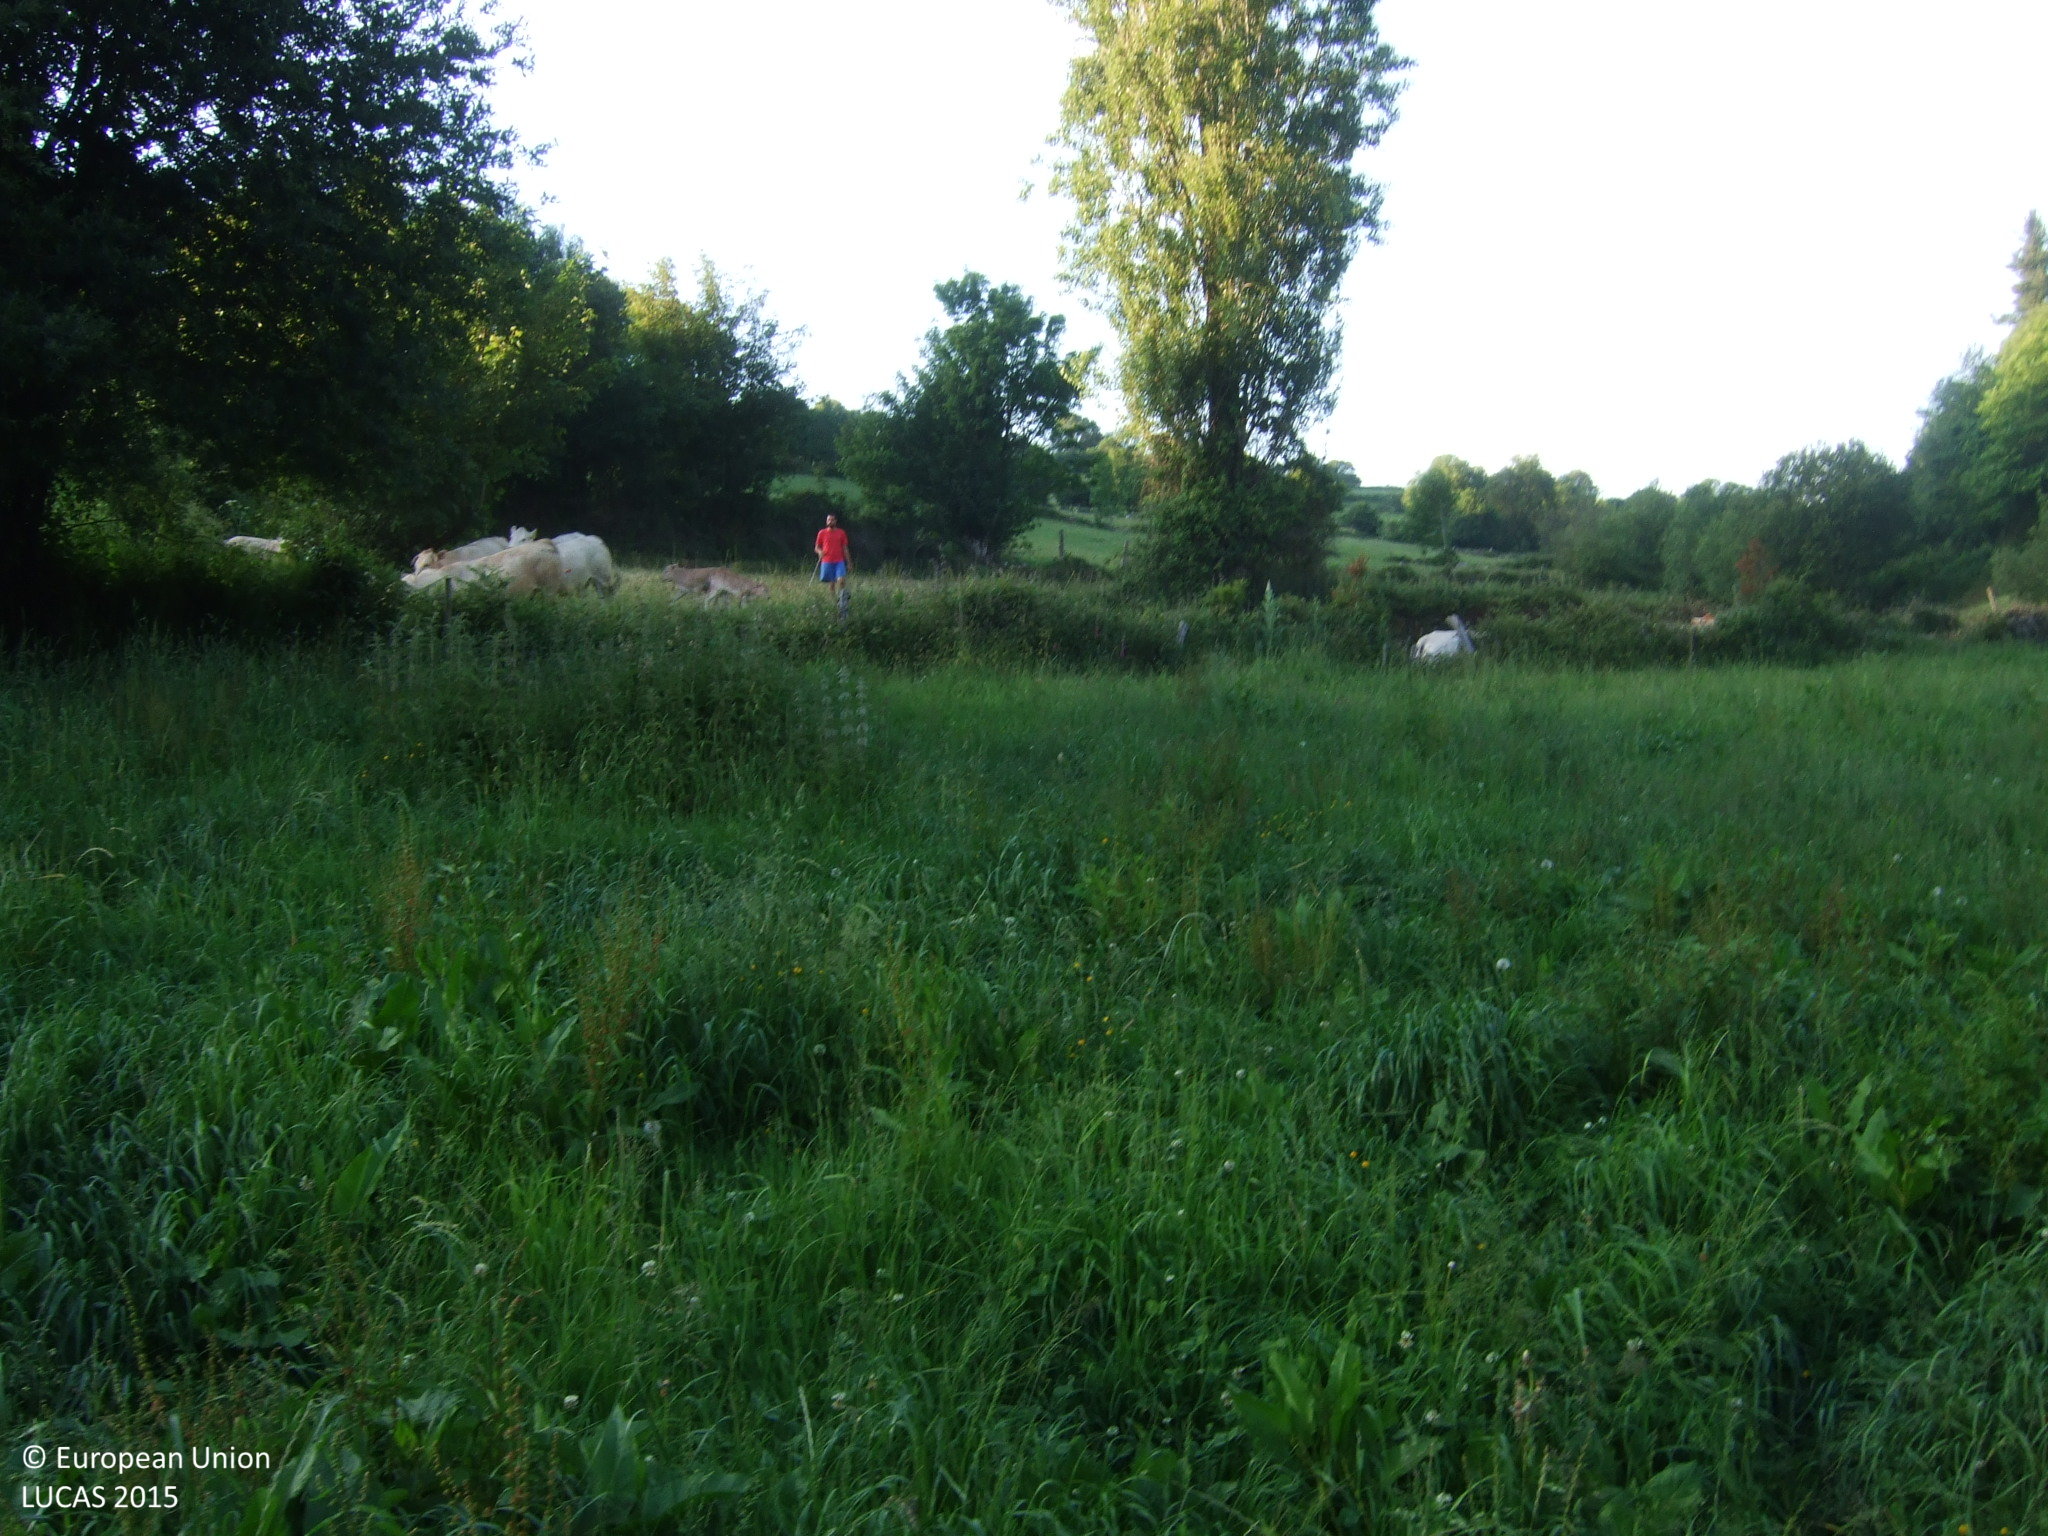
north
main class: Grassland
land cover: Grassland without tree/shrub cover
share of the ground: > 75 %
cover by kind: herbaceous plants 100 %
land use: Agriculture (excluding fallow land and kitchen gardens)
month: June
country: ES
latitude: 42.7713
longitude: -7.3121
